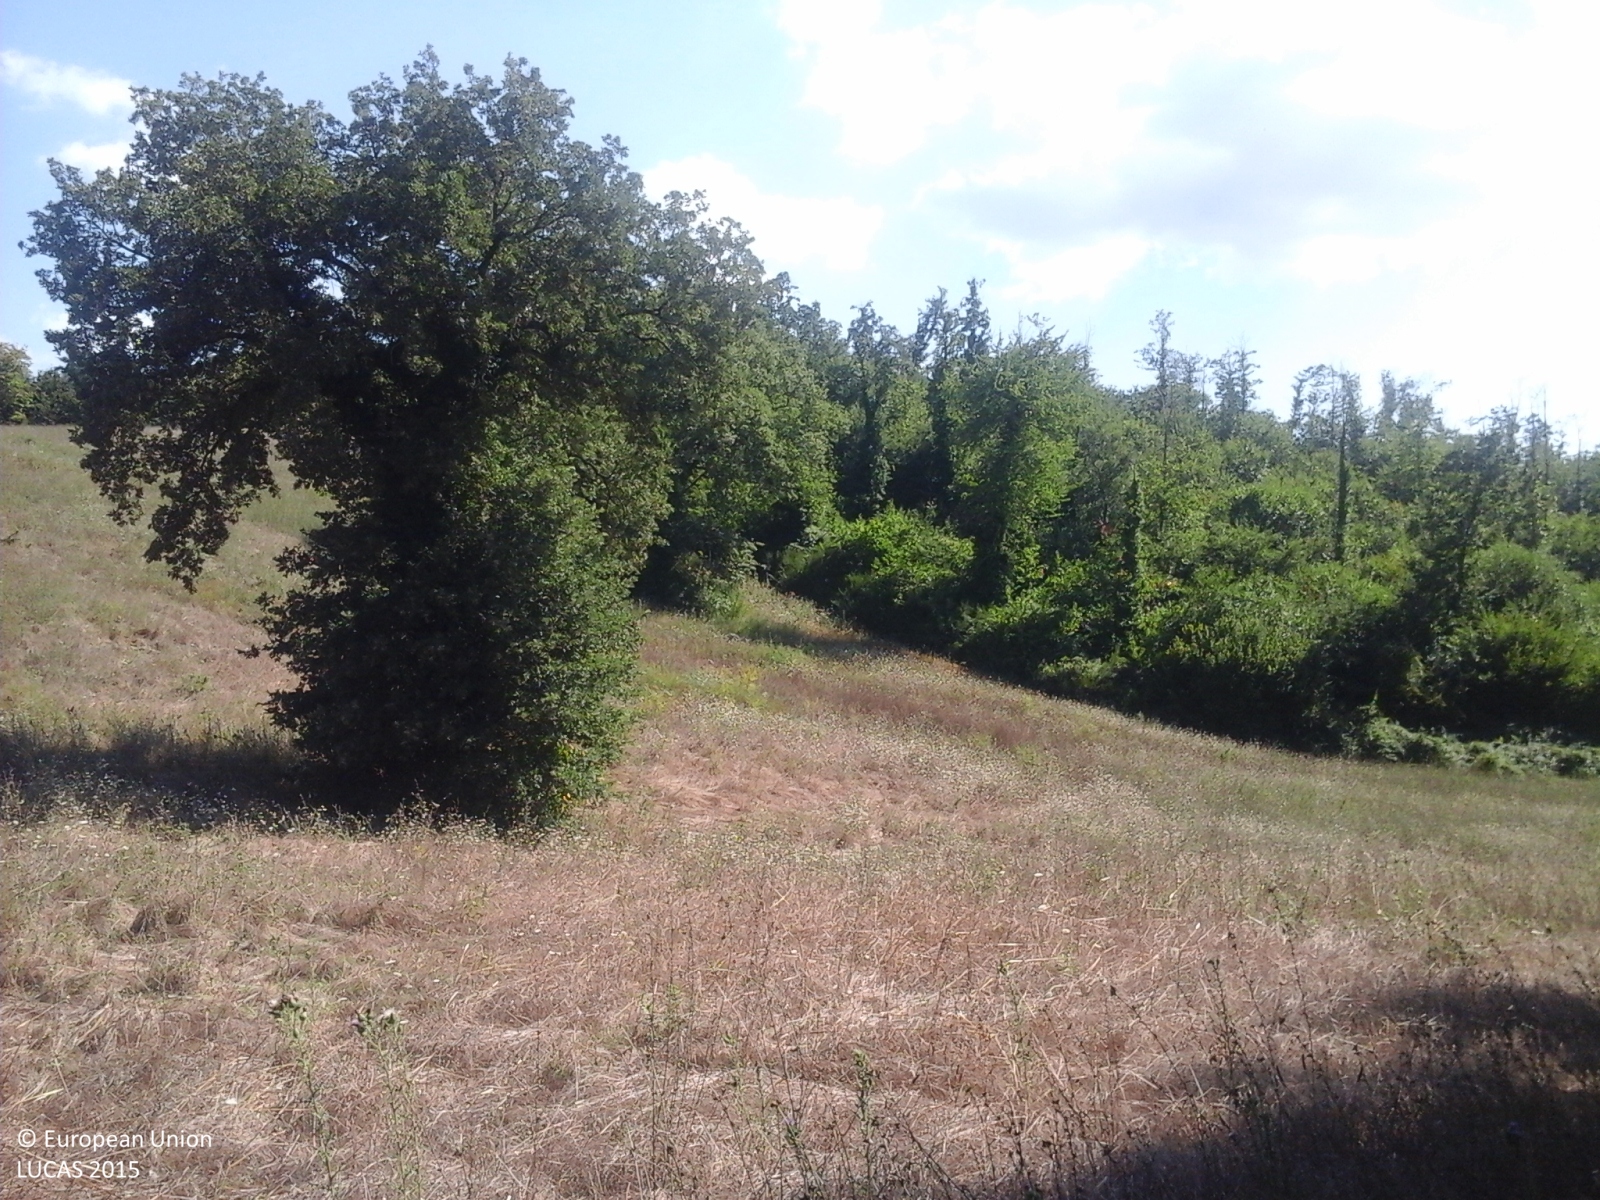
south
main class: Woodland
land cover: Broadleaved woodland
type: thermophilous deciduous forest
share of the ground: > 75 %
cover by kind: broadleaved forest trees 80 %, shrubs 20 %
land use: Forestry
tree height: < 5 m
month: August
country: IT
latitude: 42.6438
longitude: 12.3950
